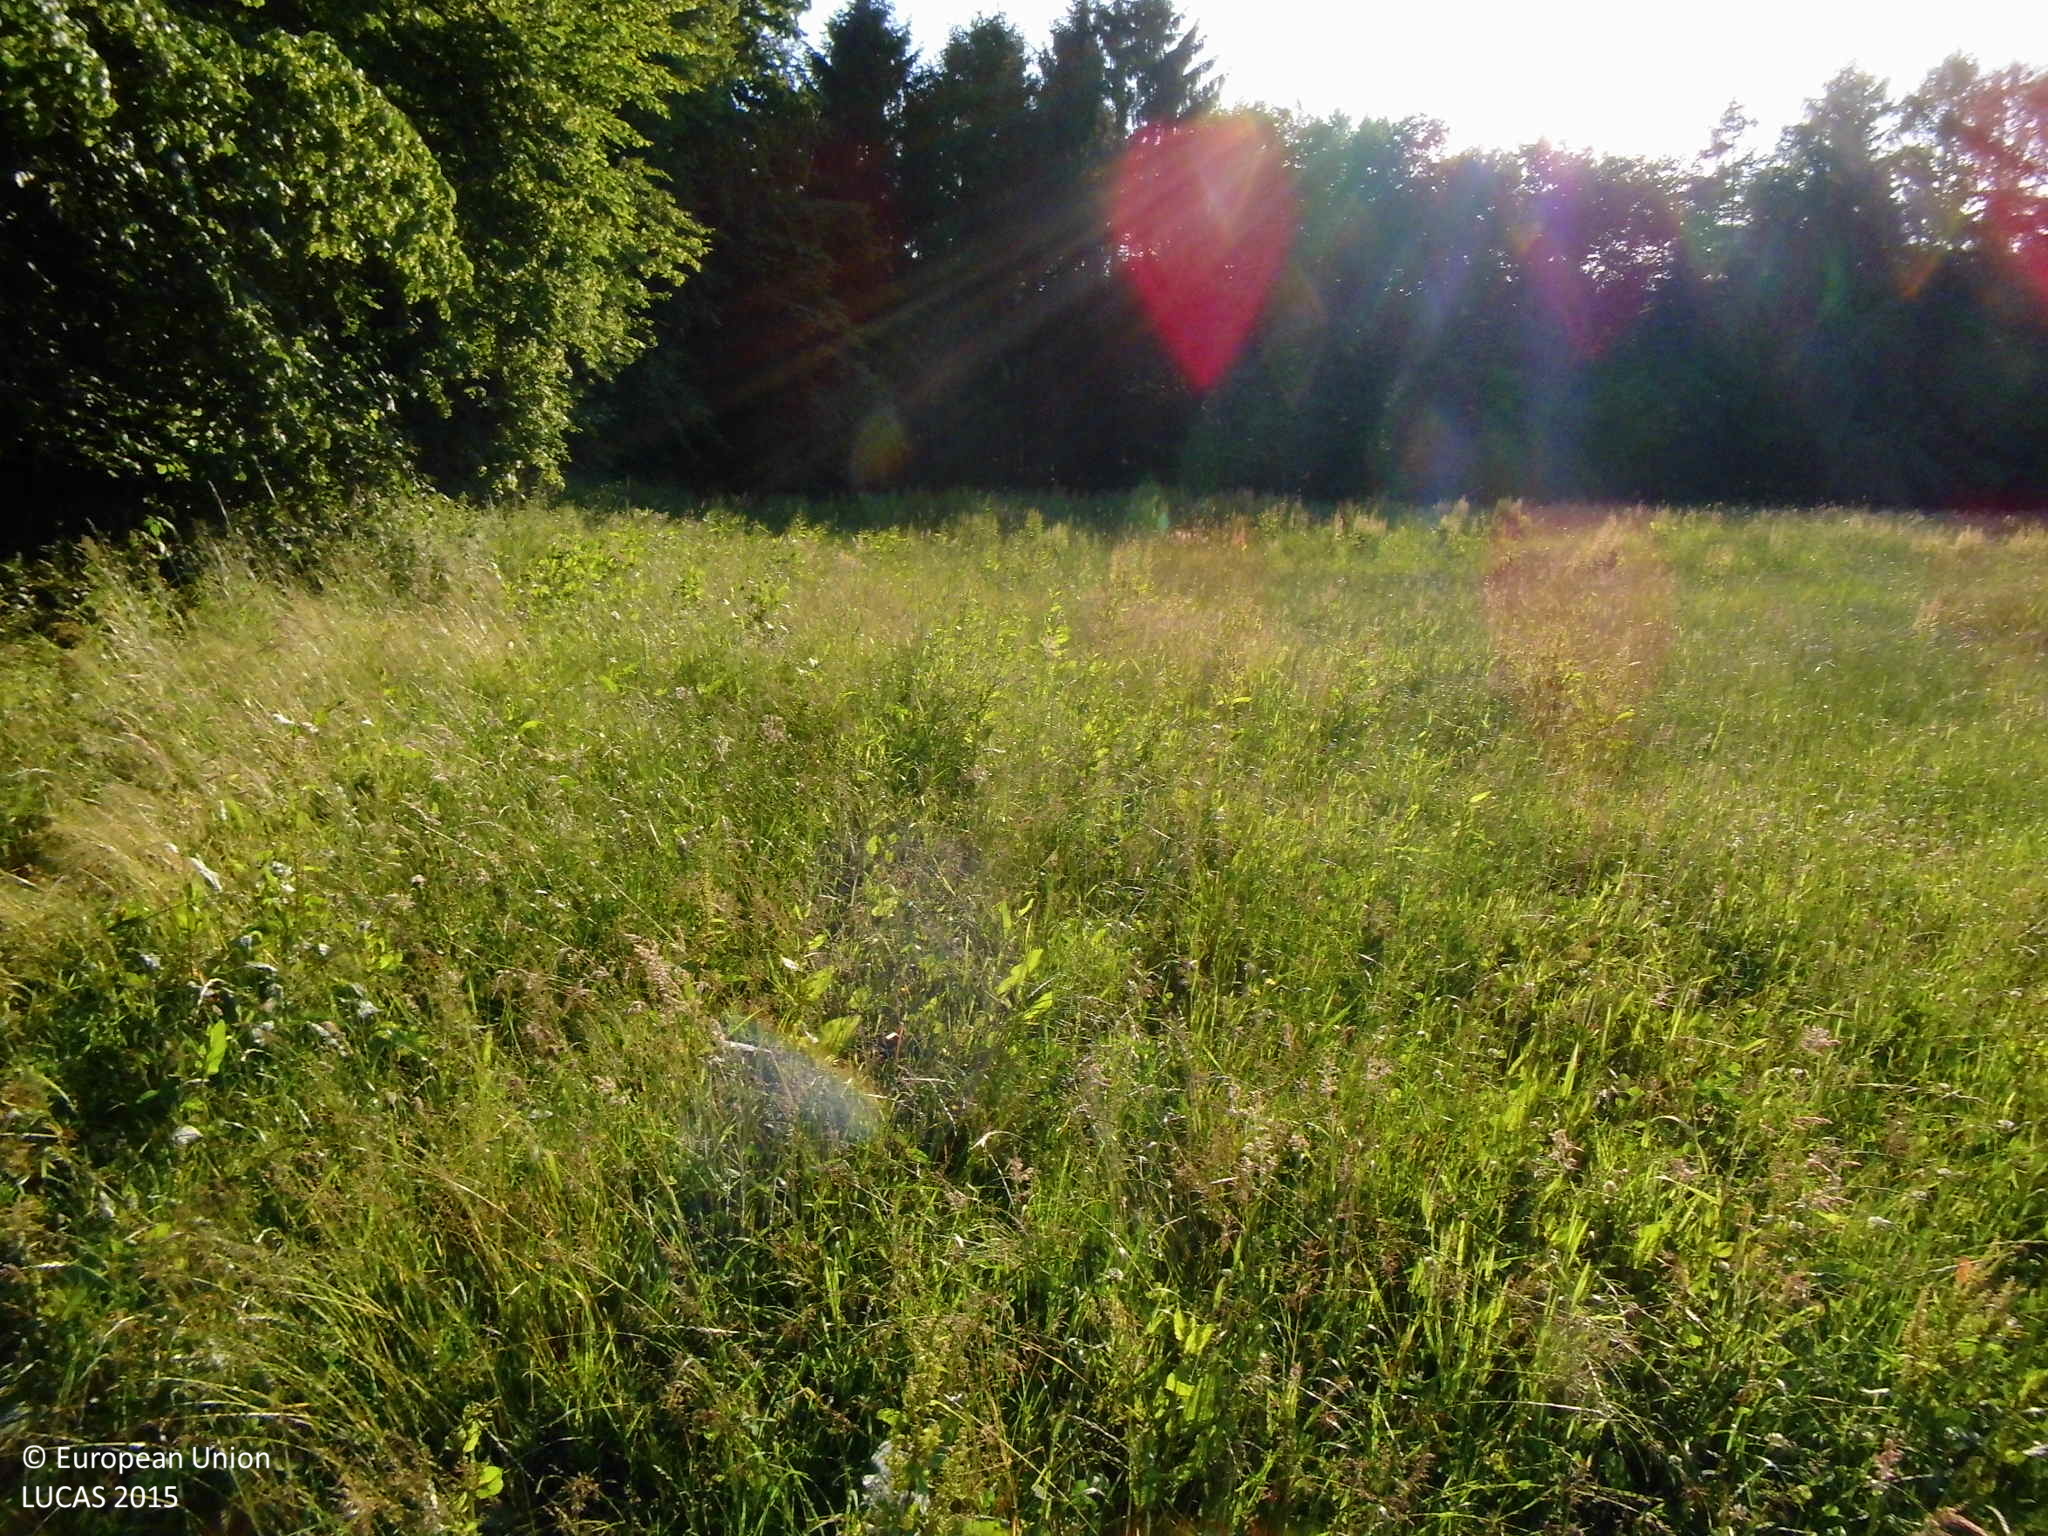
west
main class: Grassland
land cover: Grassland without tree/shrub cover
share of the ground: > 75 %
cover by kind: herbaceous plants 100 %
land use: Agriculture (excluding fallow land and kitchen gardens)
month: June
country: DE
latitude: 50.8587
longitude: 7.5141
